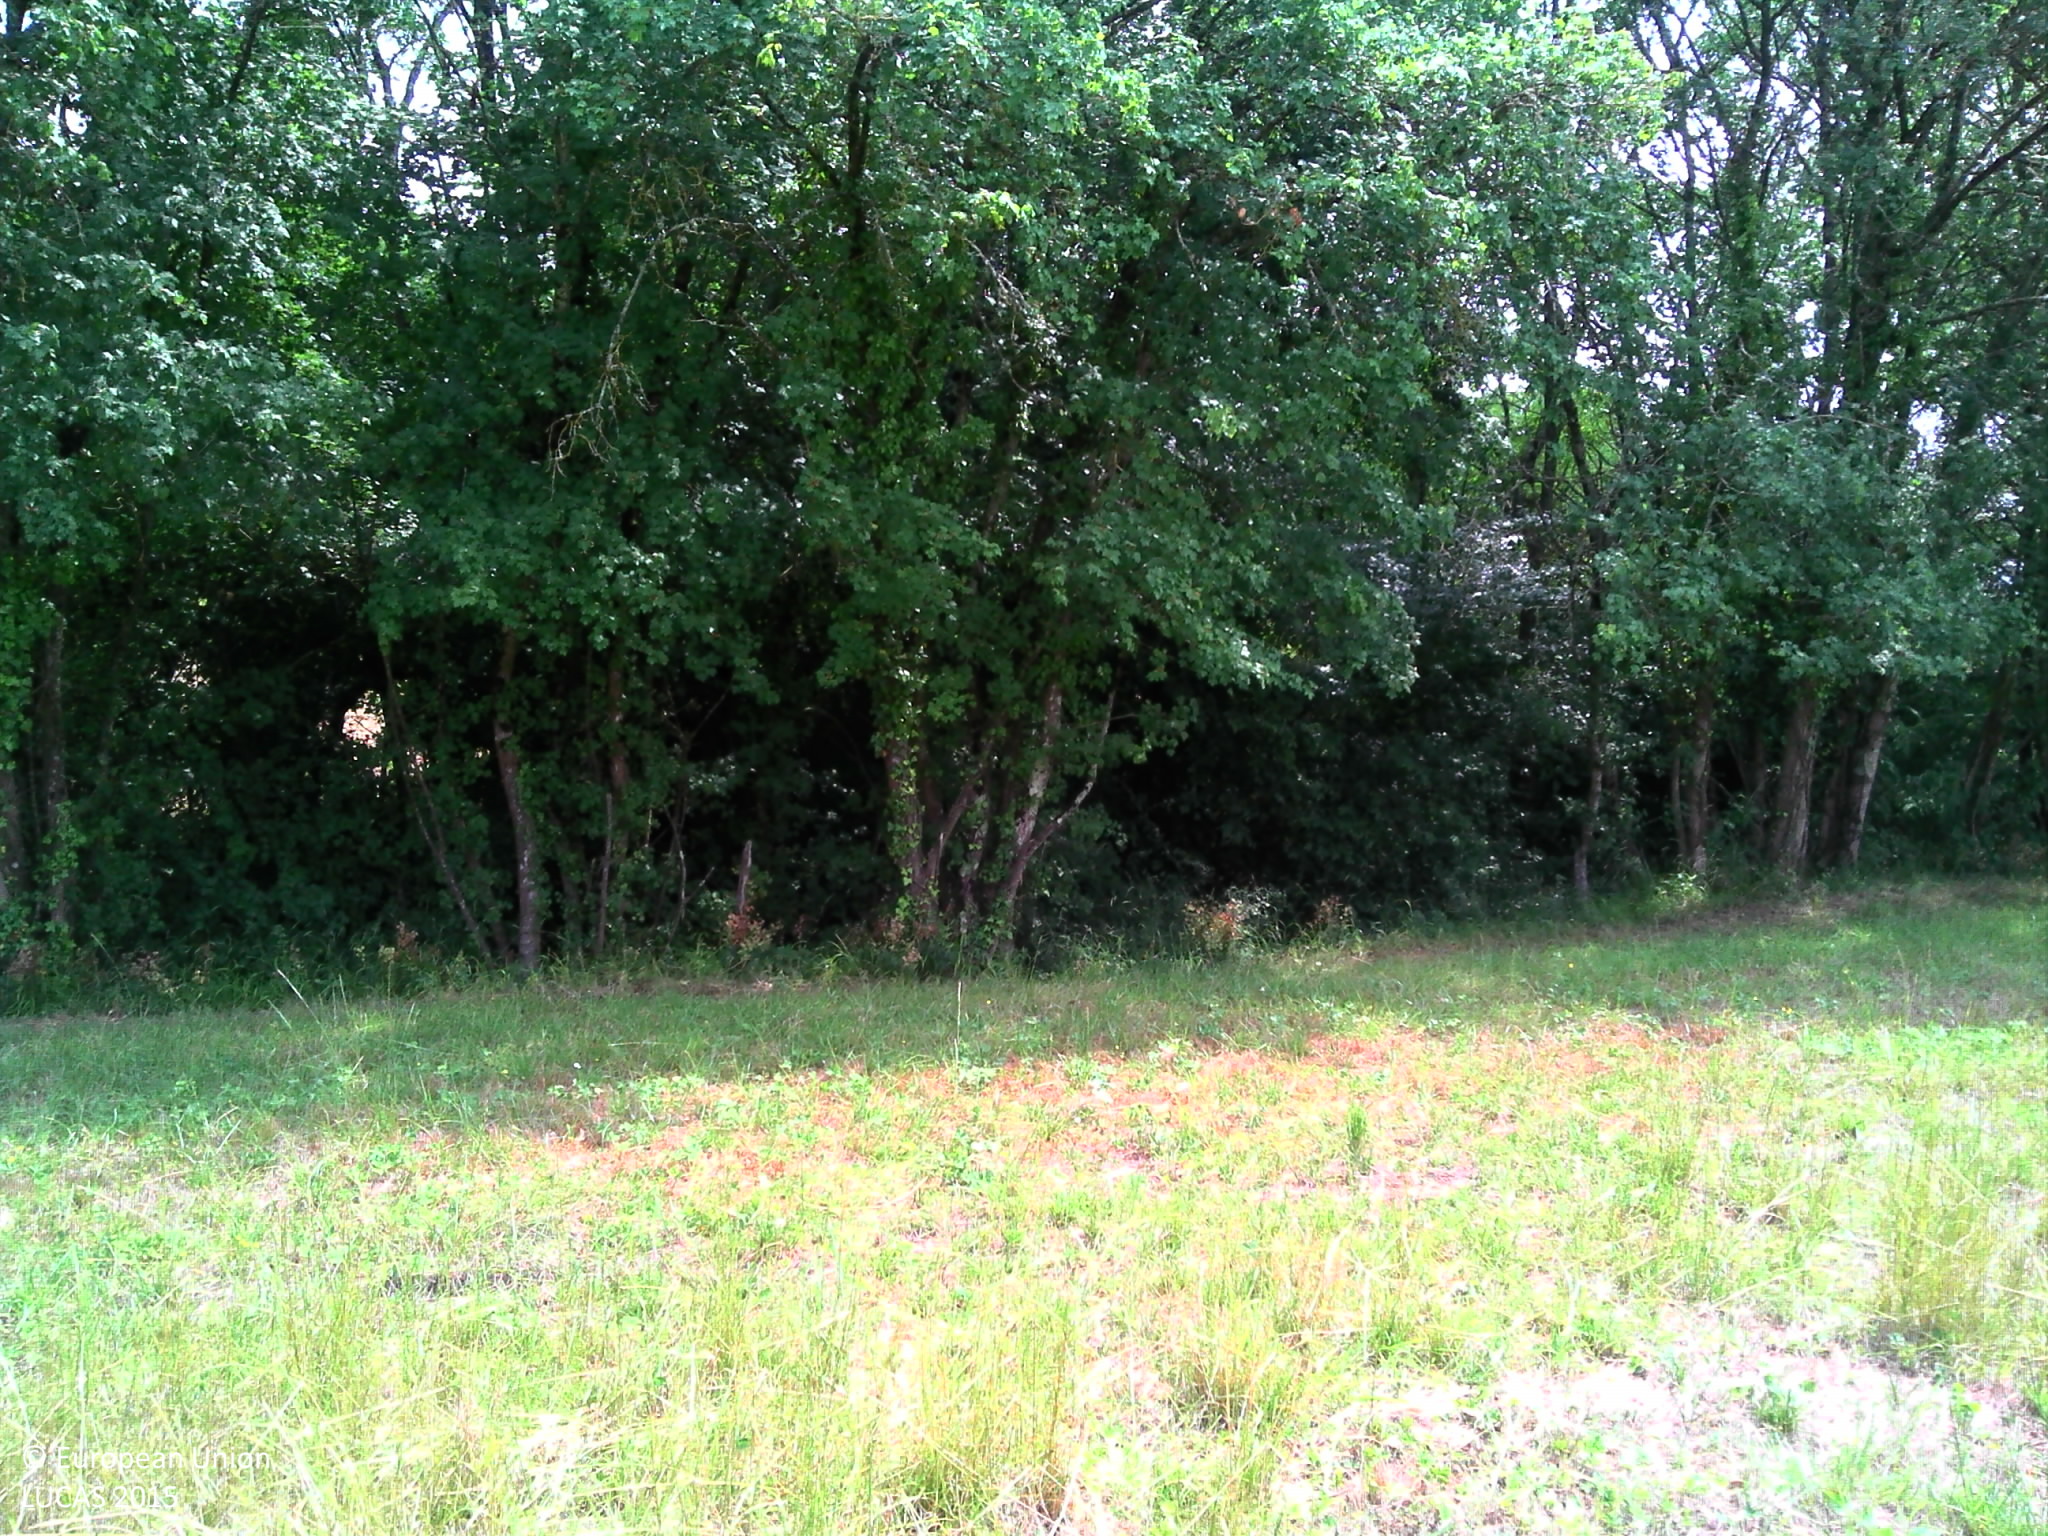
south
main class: Grassland
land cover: Grassland without tree/shrub cover
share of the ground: > 75 %
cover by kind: herbaceous plants 100 %
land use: Agriculture (excluding fallow land and kitchen gardens)
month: July
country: FR
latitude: 44.4185
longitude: 0.8643
